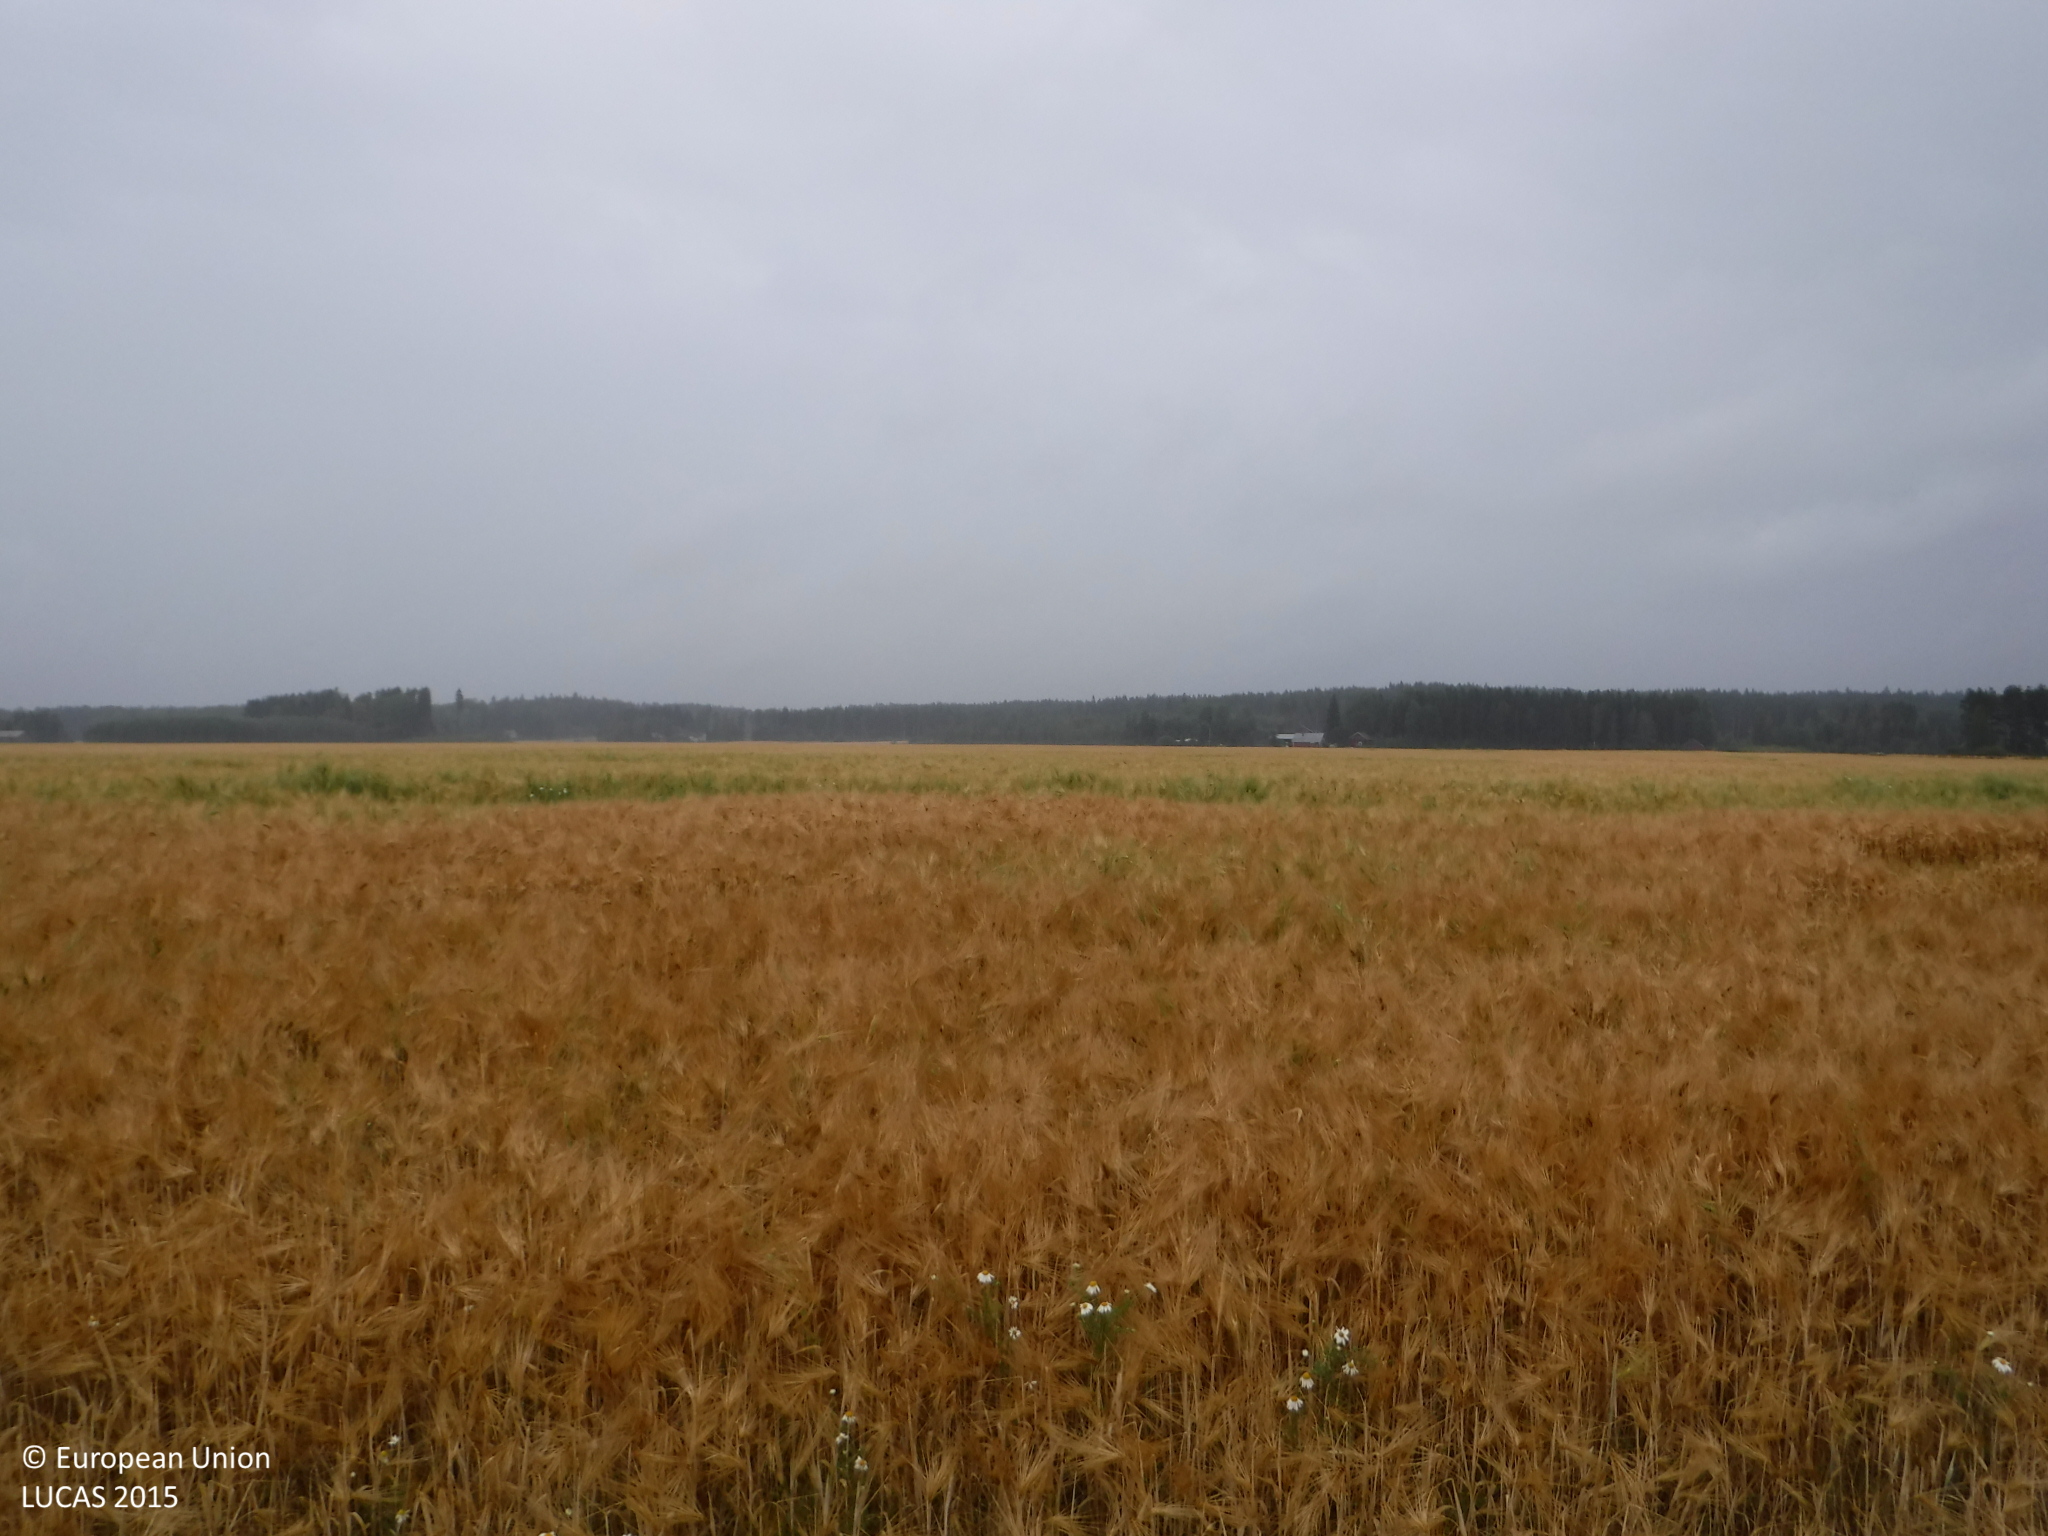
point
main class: Cropland
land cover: Barley
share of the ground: > 75 %
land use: Agriculture (excluding fallow land and kitchen gardens)
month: August
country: FI
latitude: 61.2095
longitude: 22.9340
